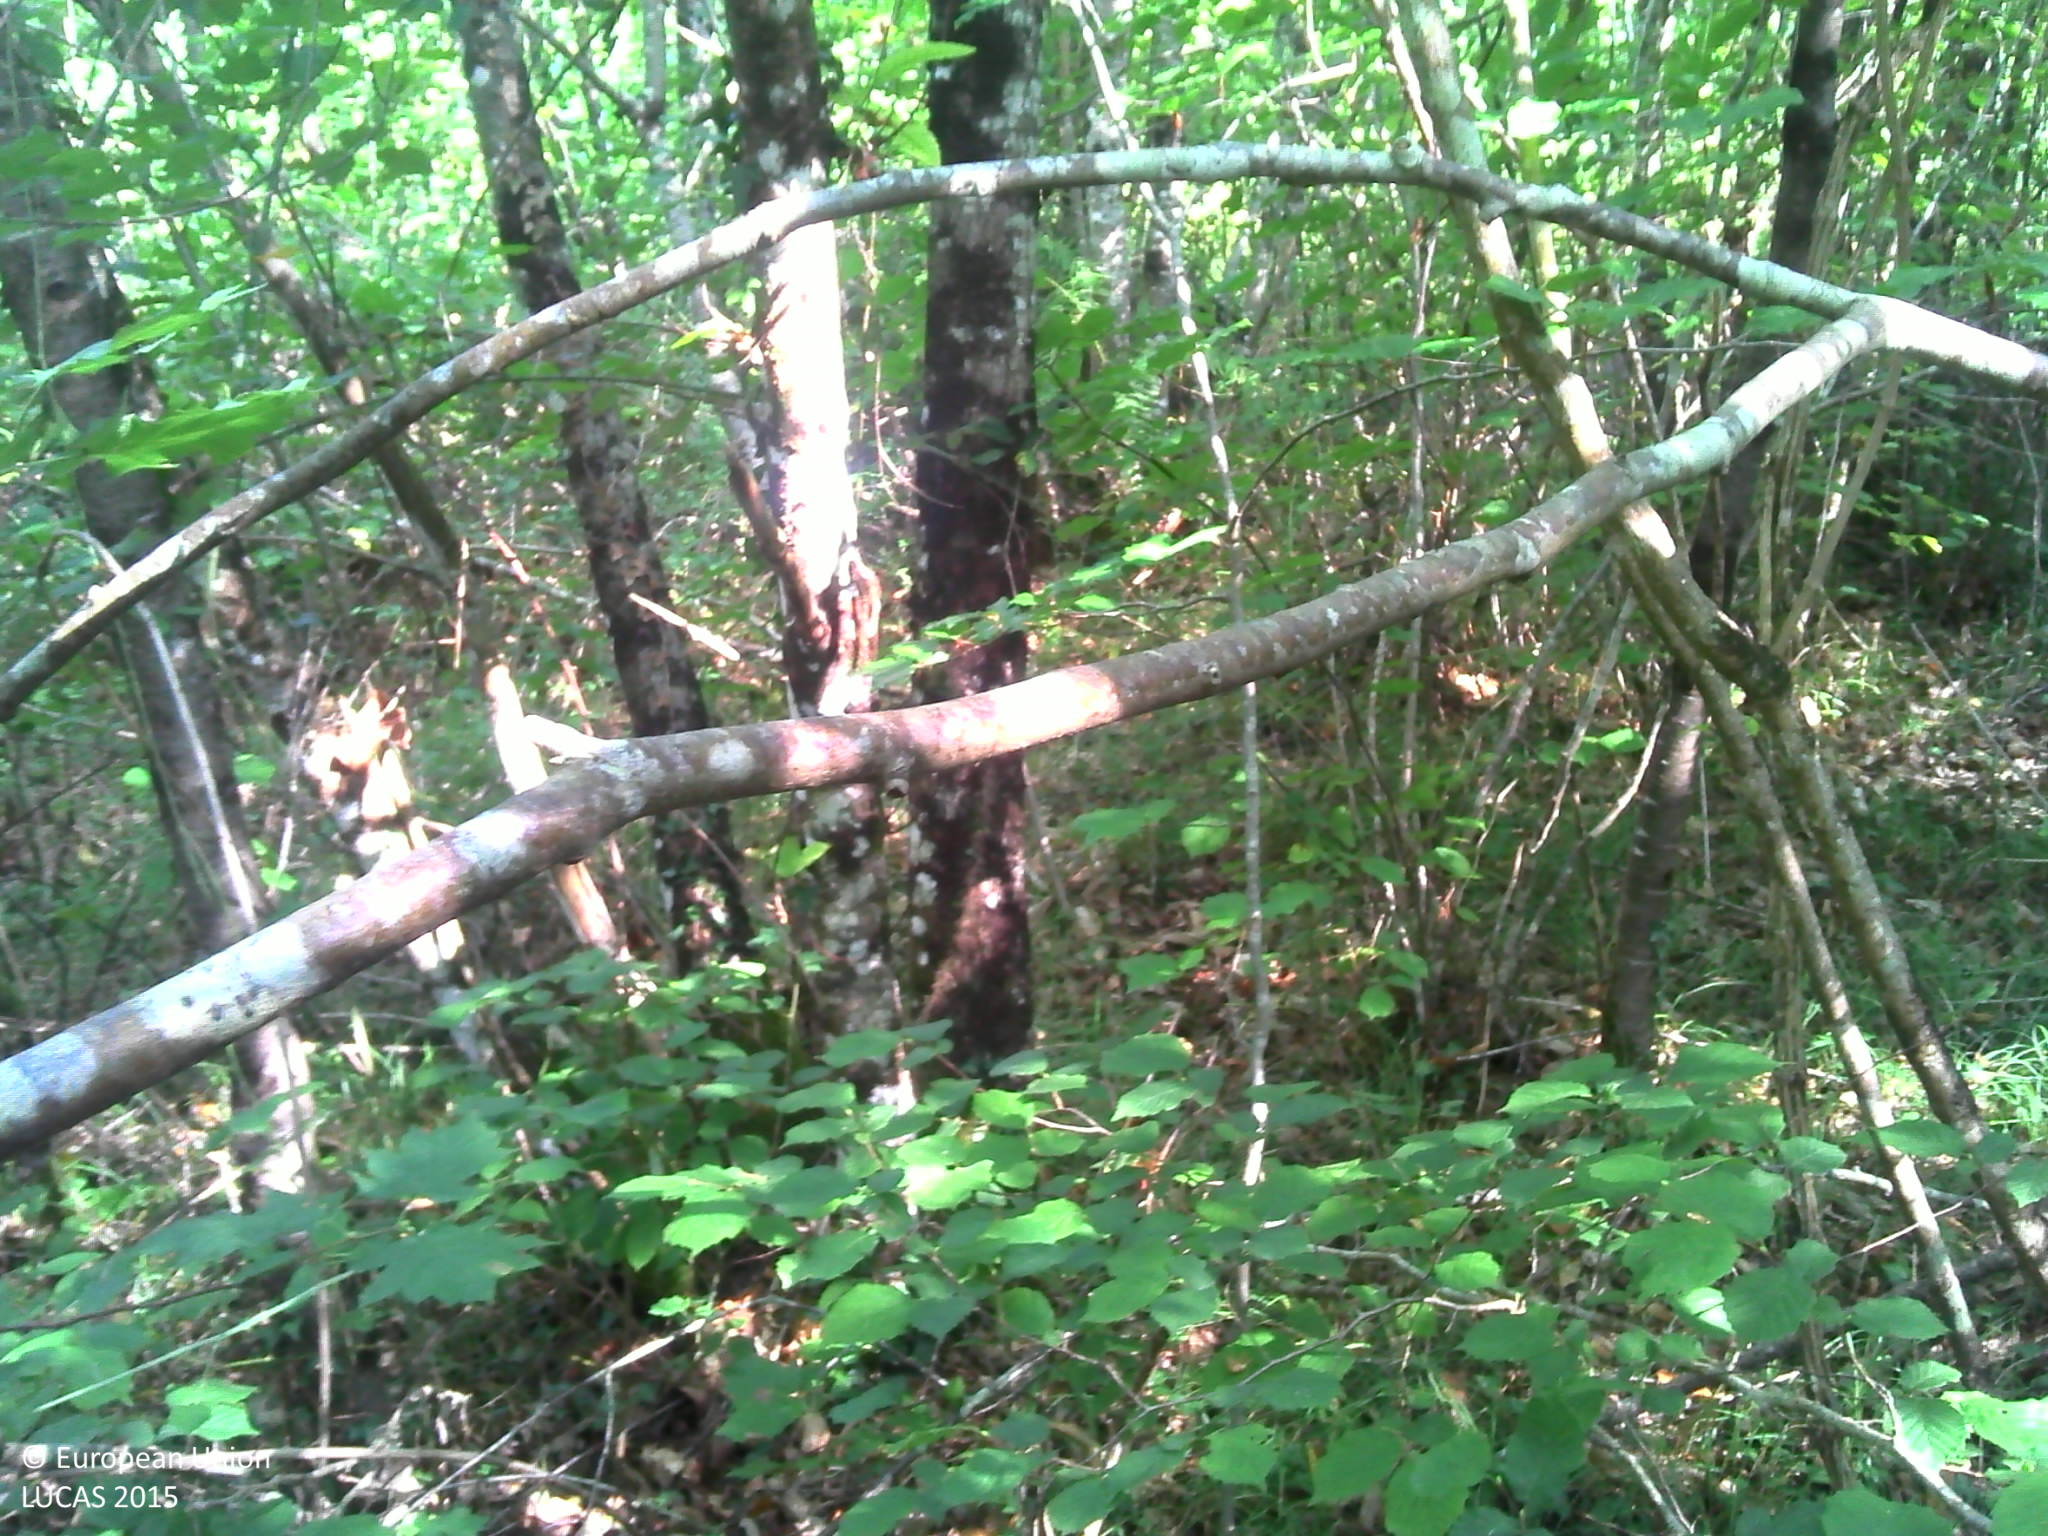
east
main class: Woodland
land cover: Broadleaved woodland
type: mesophytic deciduous forest
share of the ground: > 75 %
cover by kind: broadleaved forest trees 100 %
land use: Semi-natural and natural areas not in use
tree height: > 5 m
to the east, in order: Broadleaved woodland; Shrubland with sparse tree cover; Electric lines; Shrubland with sparse tree cover; Broadleaved woodland; Tracks; Broadleaved woodland; Tracks; Broadleaved woodland; Ditches and canals; Broadleaved woodland; Fences; Grassland without tree/shrub cover
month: September
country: FR
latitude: 47.0737
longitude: 1.4139
